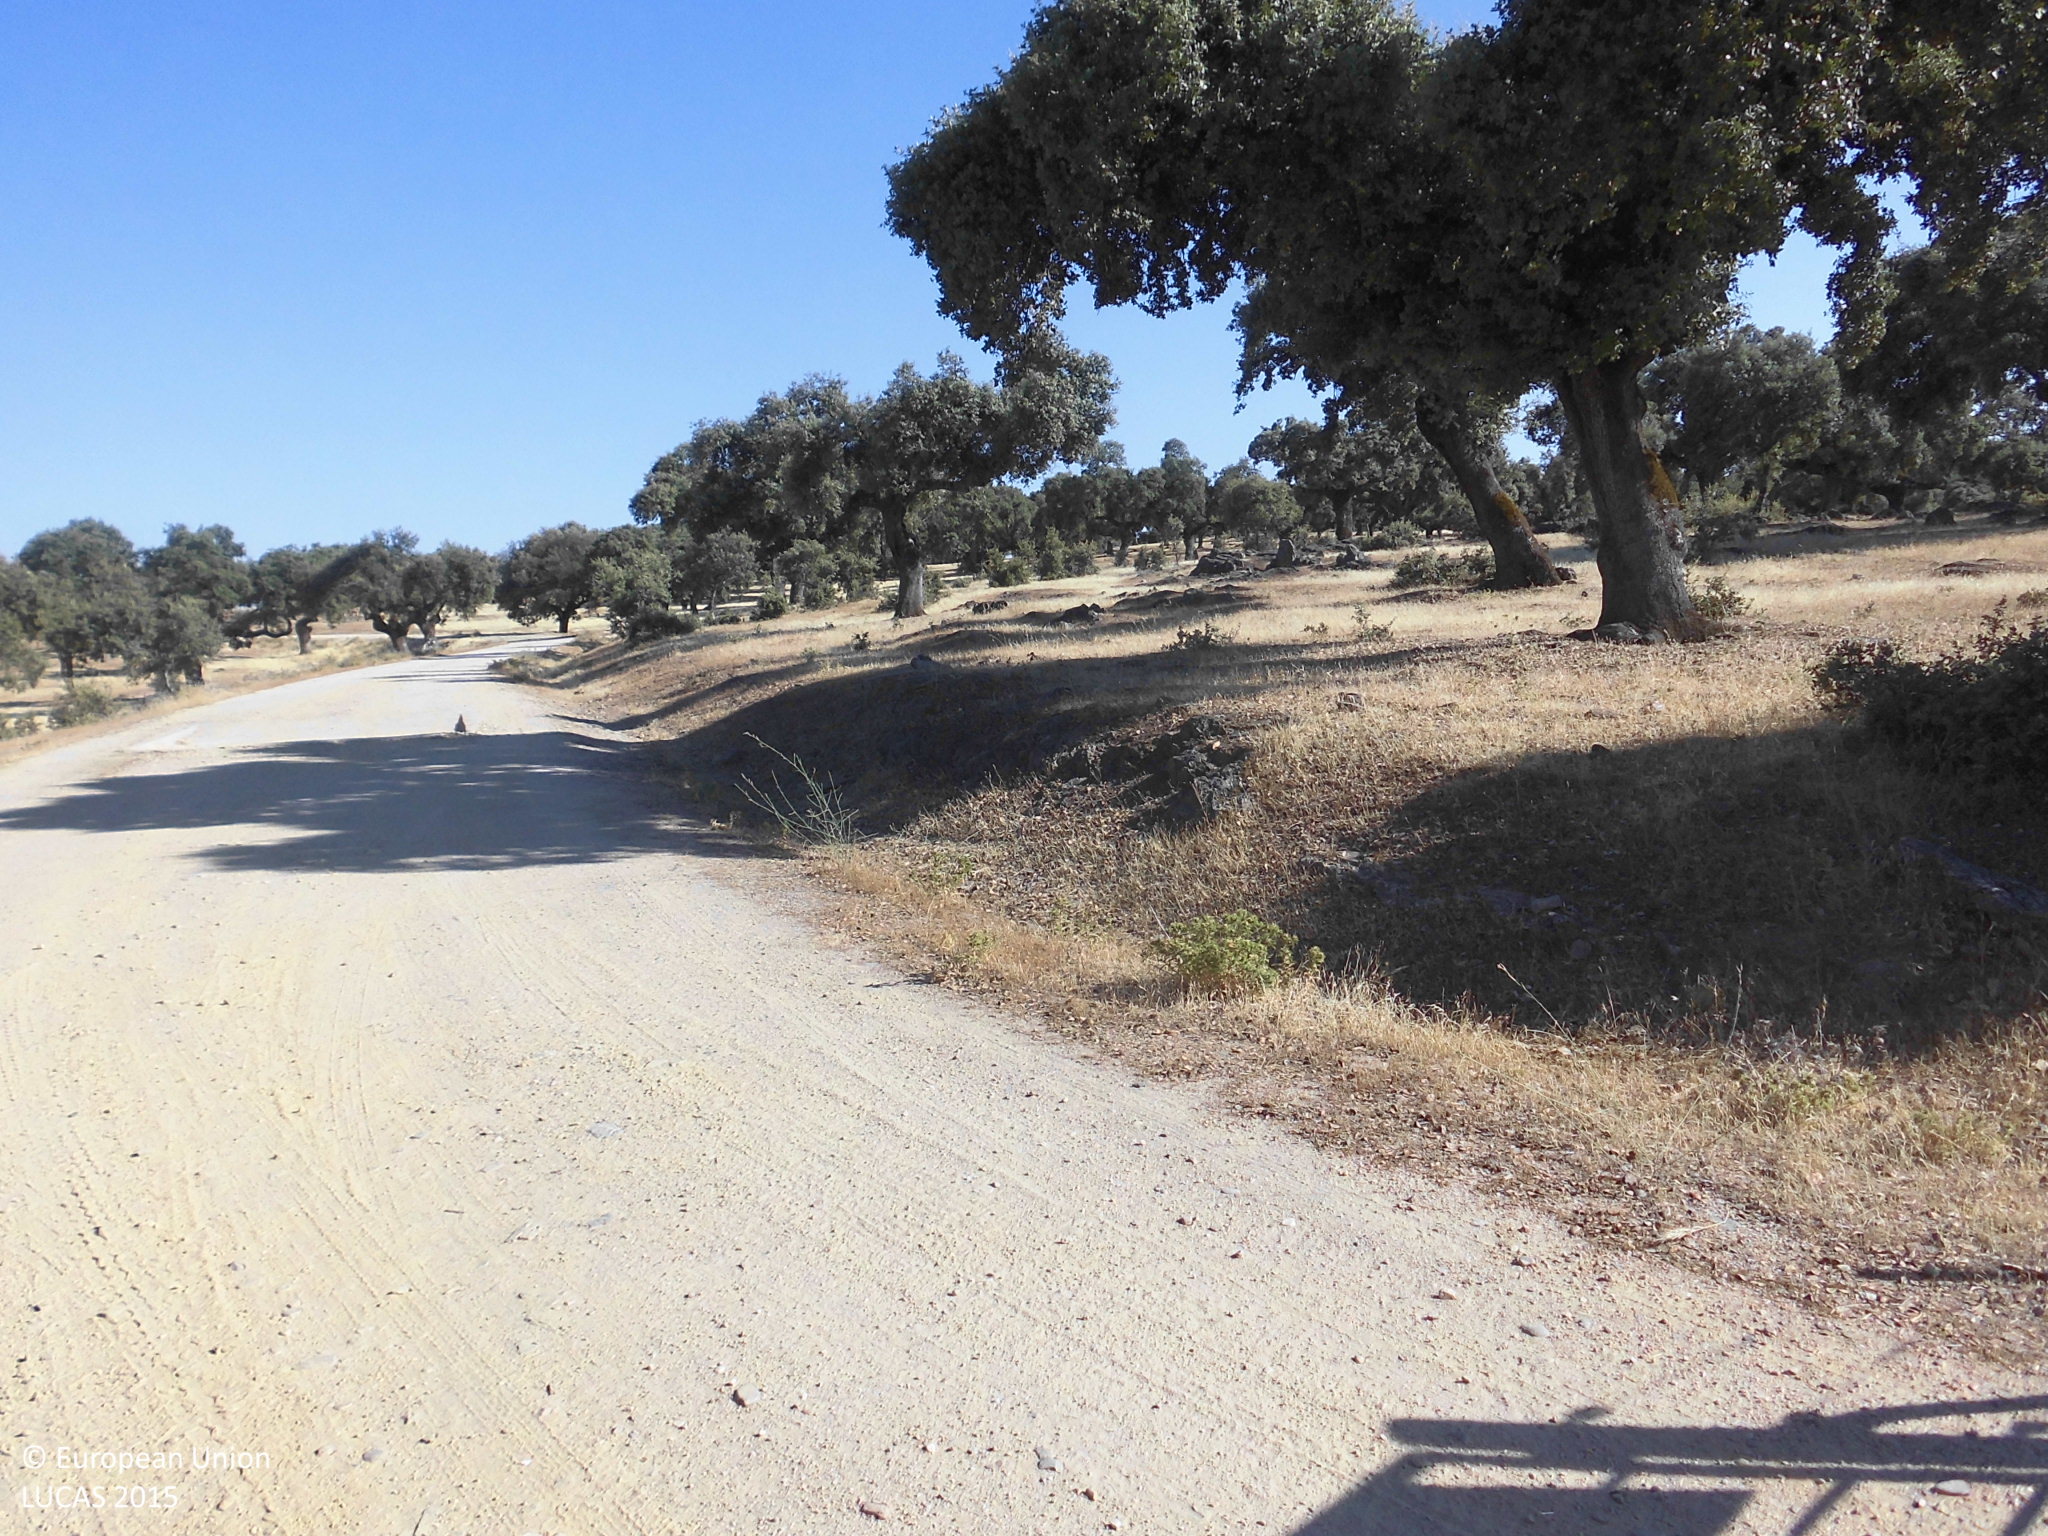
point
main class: Woodland
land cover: Broadleaved woodland
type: broadleaved evergreen forest
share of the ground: 50 - 75 %
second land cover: Grassland without tree/shrub cover
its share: > 75 %
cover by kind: broadleaved forest trees 60 %, herbaceous plants 40 %
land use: Forestry
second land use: Agriculture (excluding fallow land and kitchen gardens)
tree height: > 5 m
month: July
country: ES
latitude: 39.5282
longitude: -5.5848
